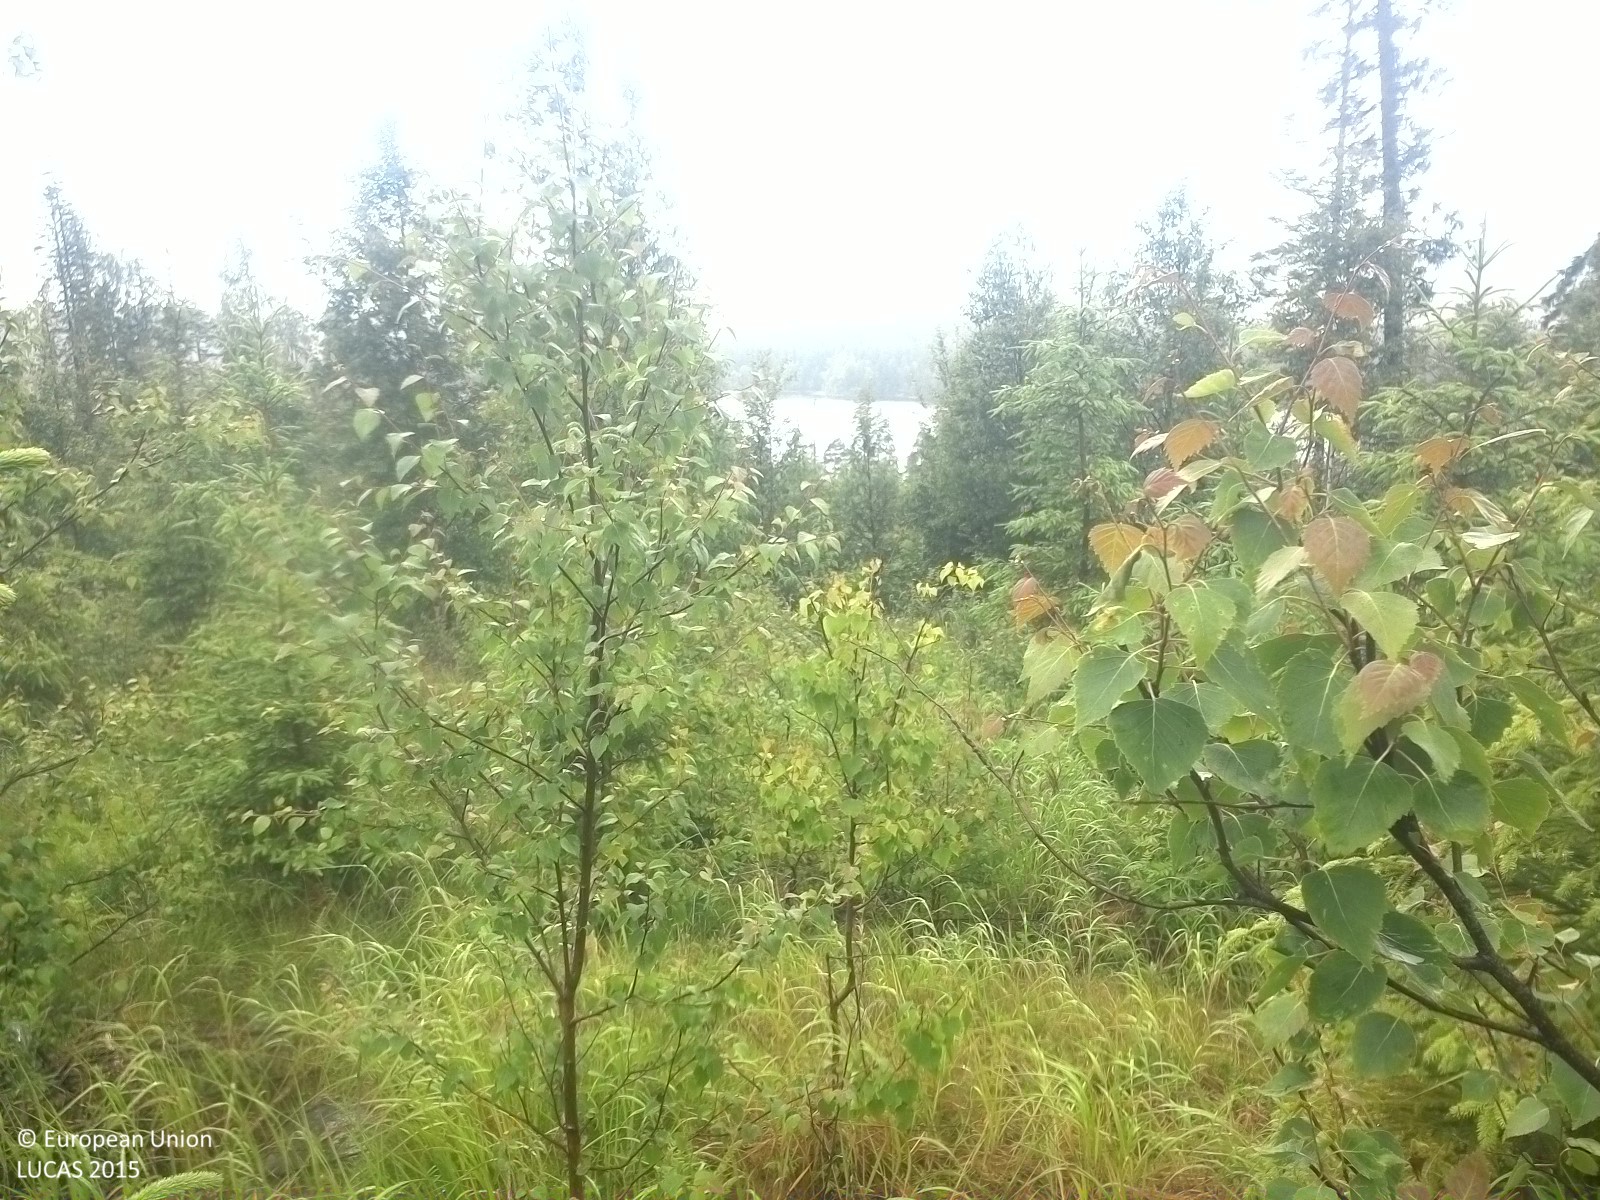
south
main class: Woodland
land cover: Spruce dominated mixed woodland
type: boreal forest
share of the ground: 50 - 75 %
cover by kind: herbaceous plants 45 %, coniferous forest trees 35 %, broadleaved forest trees 20 %
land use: Forestry
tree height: < 5 m
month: July
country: SE
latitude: 62.5277
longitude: 16.8771
